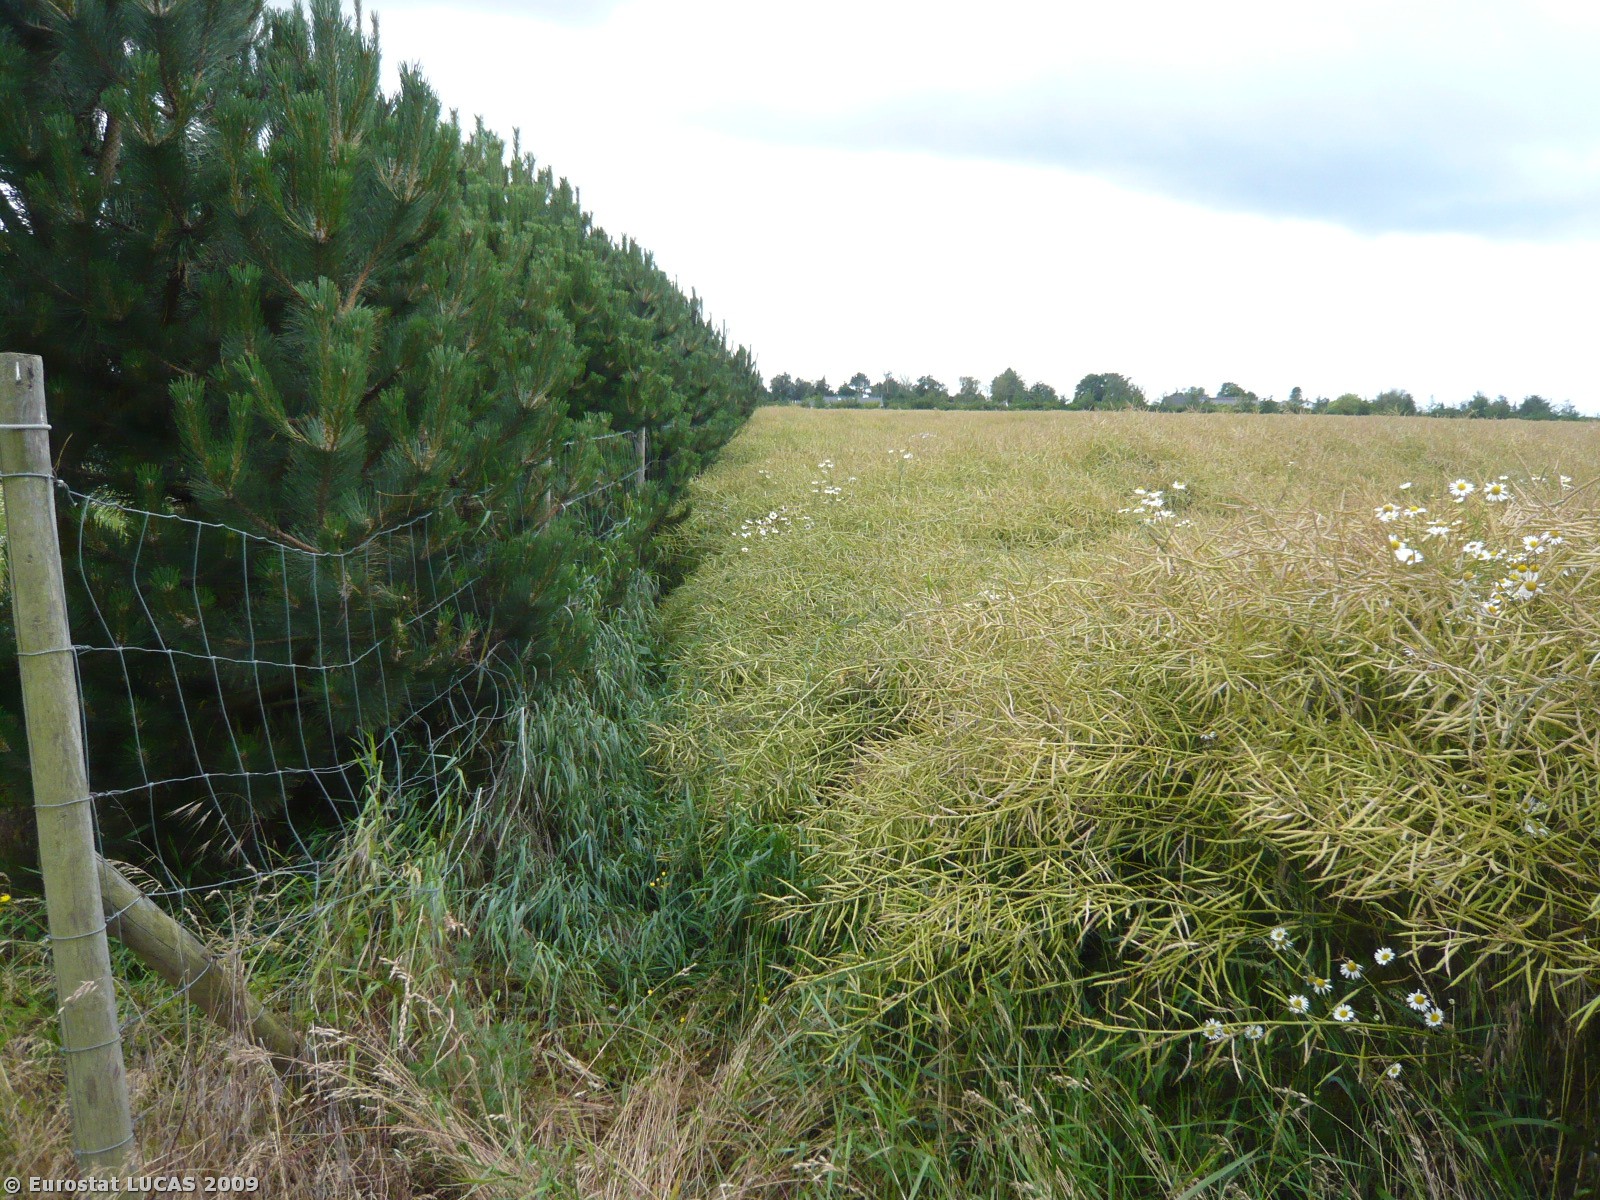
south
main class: Cropland
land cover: Rape and turnip rape
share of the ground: > 75 %
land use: Agriculture (excluding fallow land and kitchen gardens)
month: July
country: DK
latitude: 55.4090
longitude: 11.2151
